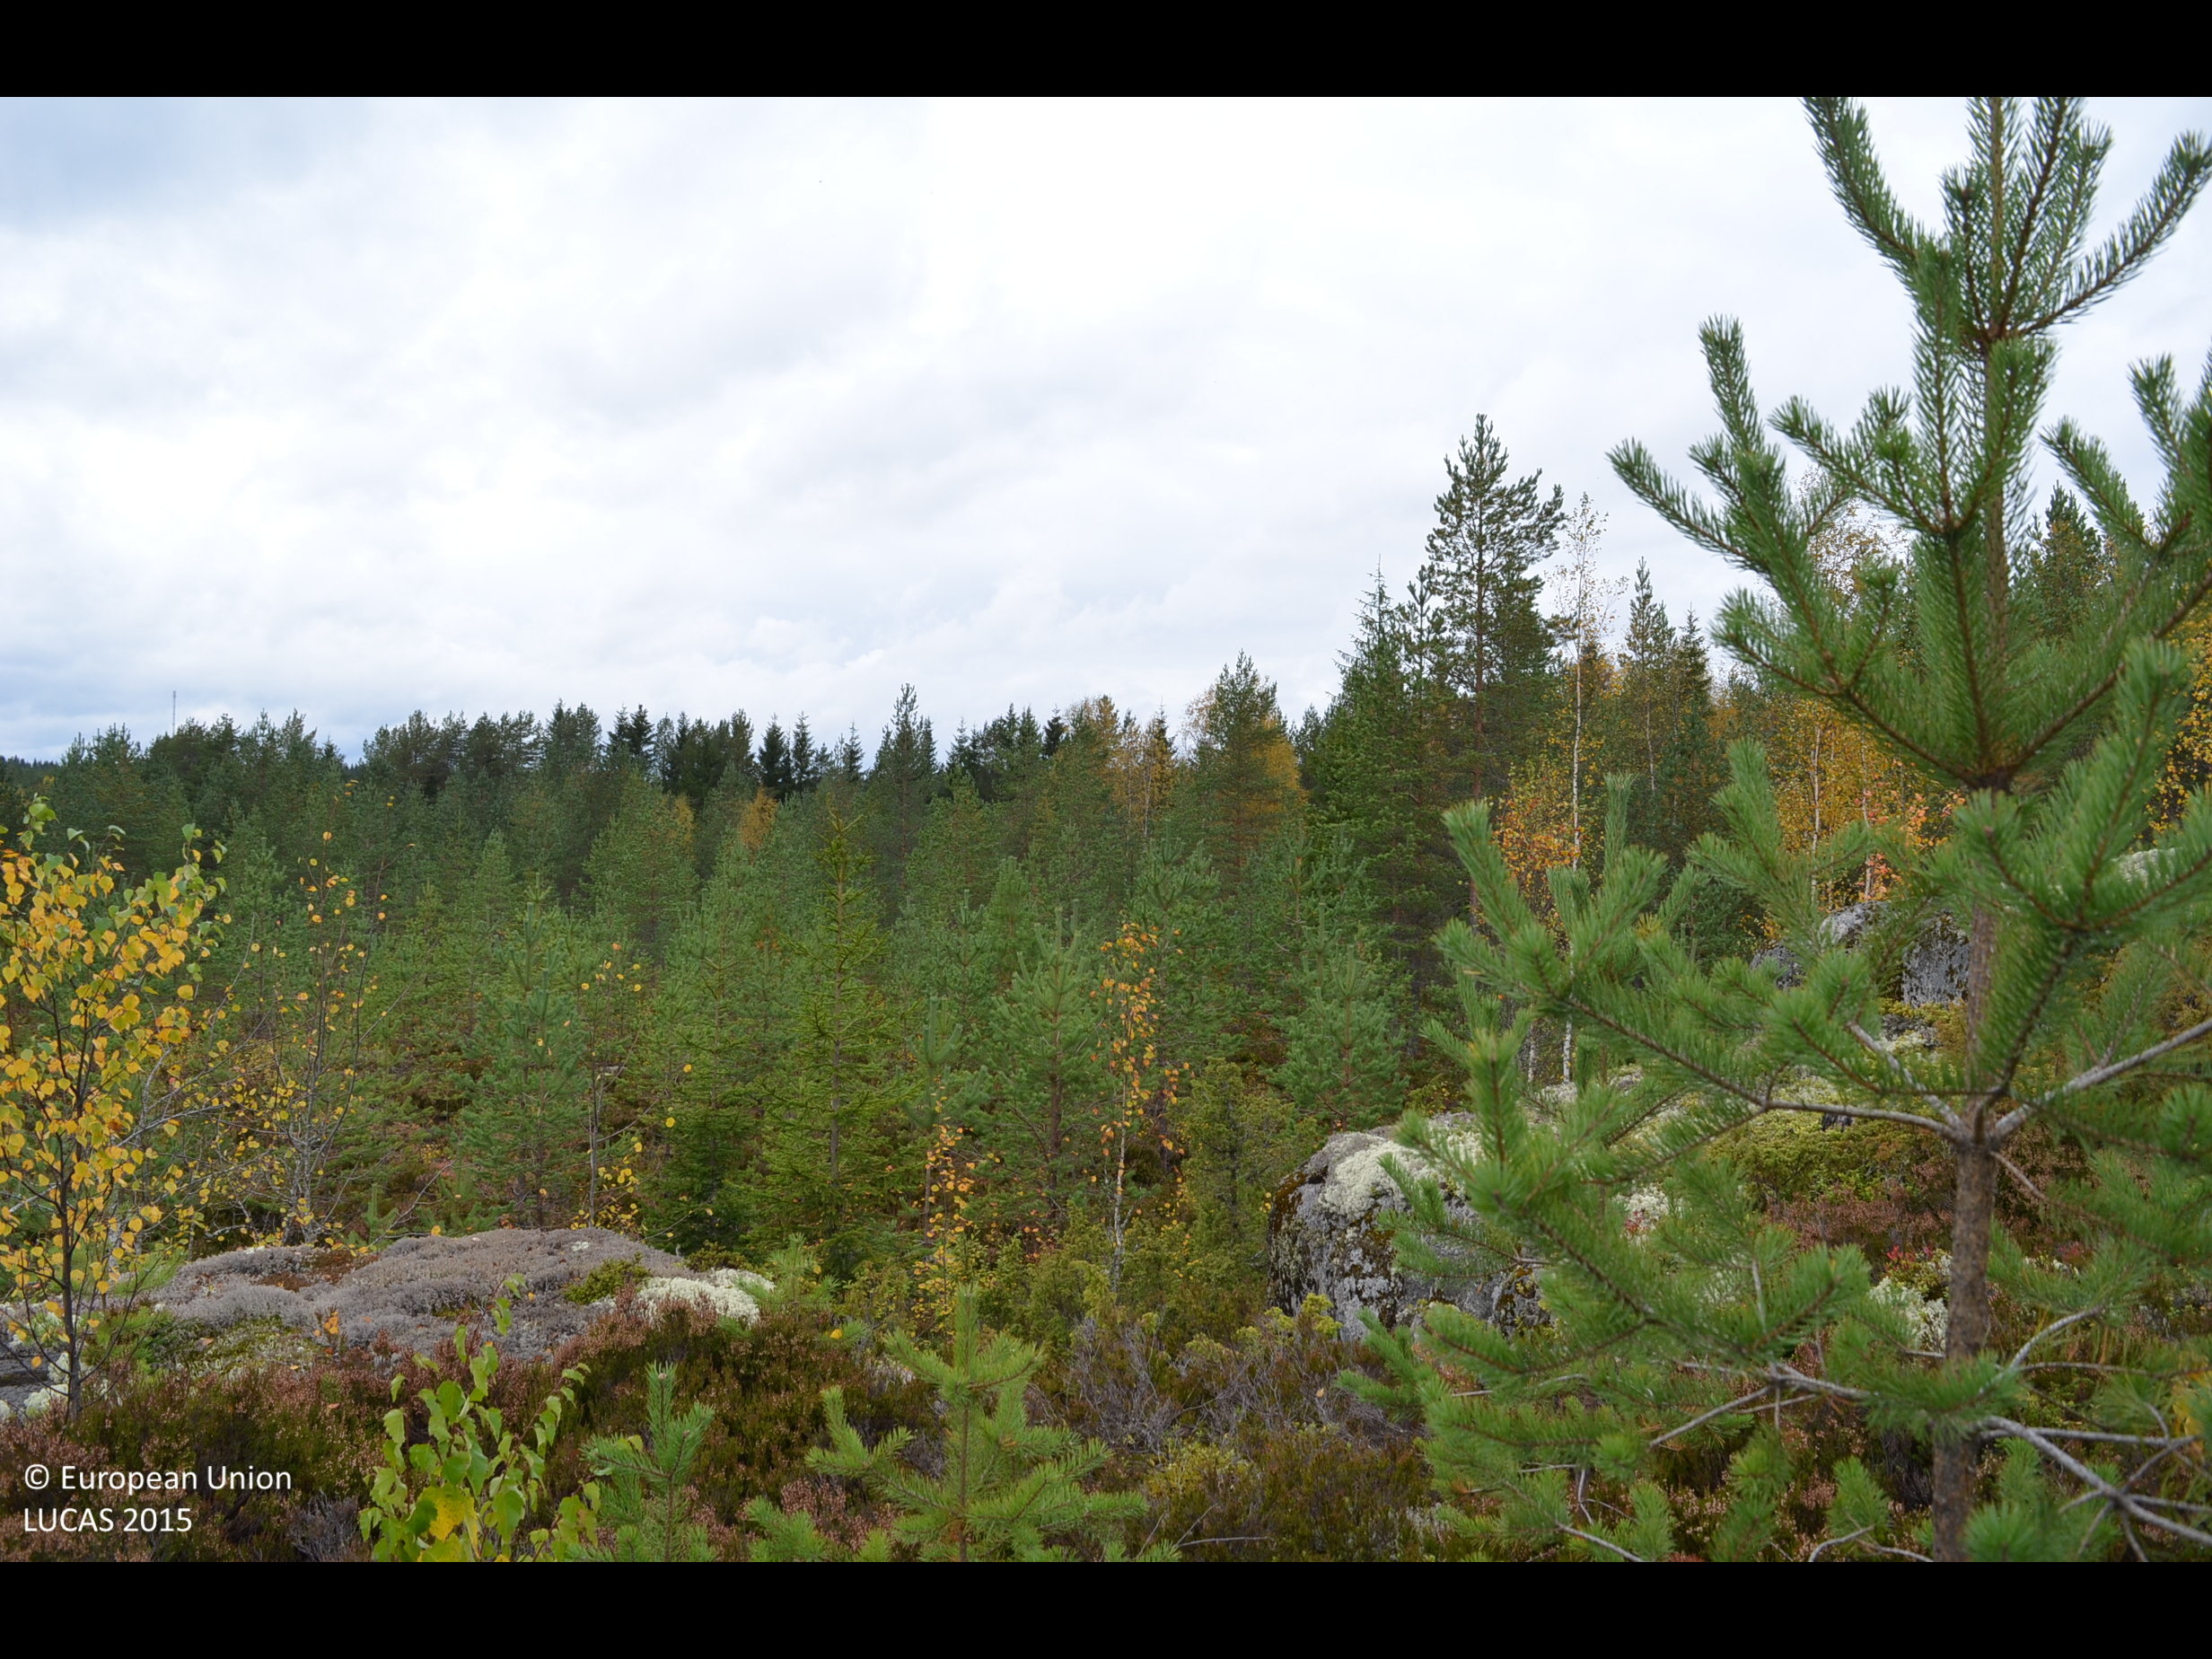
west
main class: Woodland
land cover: Pine dominated mixed woodland
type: boreal forest
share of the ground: 25 - 50 %
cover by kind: coniferous forest trees 30 %, shrubs 20 %, lichens and mosses 20 %, broadleaved forest trees 15 %, unconsolidated bare surface 15 %
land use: Forestry
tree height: < 5 m
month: September
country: FI
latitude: 62.7198
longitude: 23.8628
